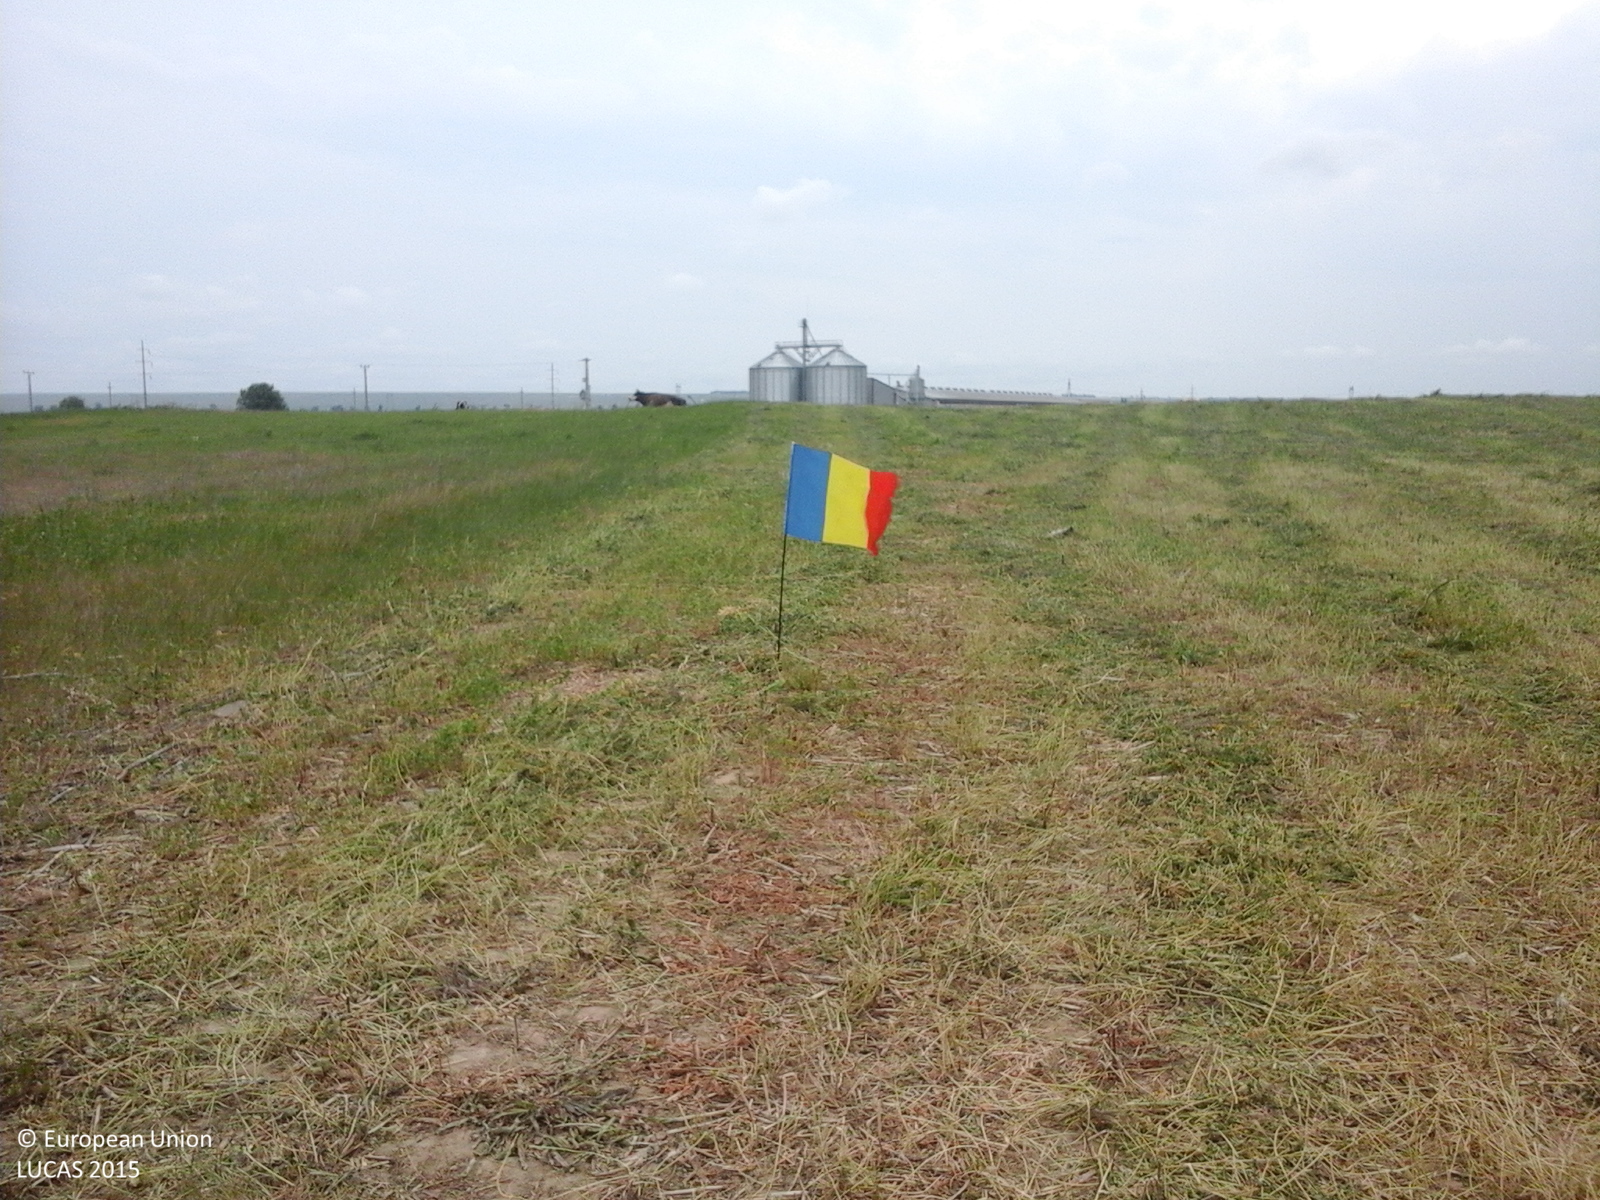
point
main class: Cropland
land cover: Other leguminous and mixtures for fodder
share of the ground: > 75 %
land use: Agriculture (excluding fallow land and kitchen gardens)
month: June
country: RO
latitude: 47.0884
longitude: 26.6756
